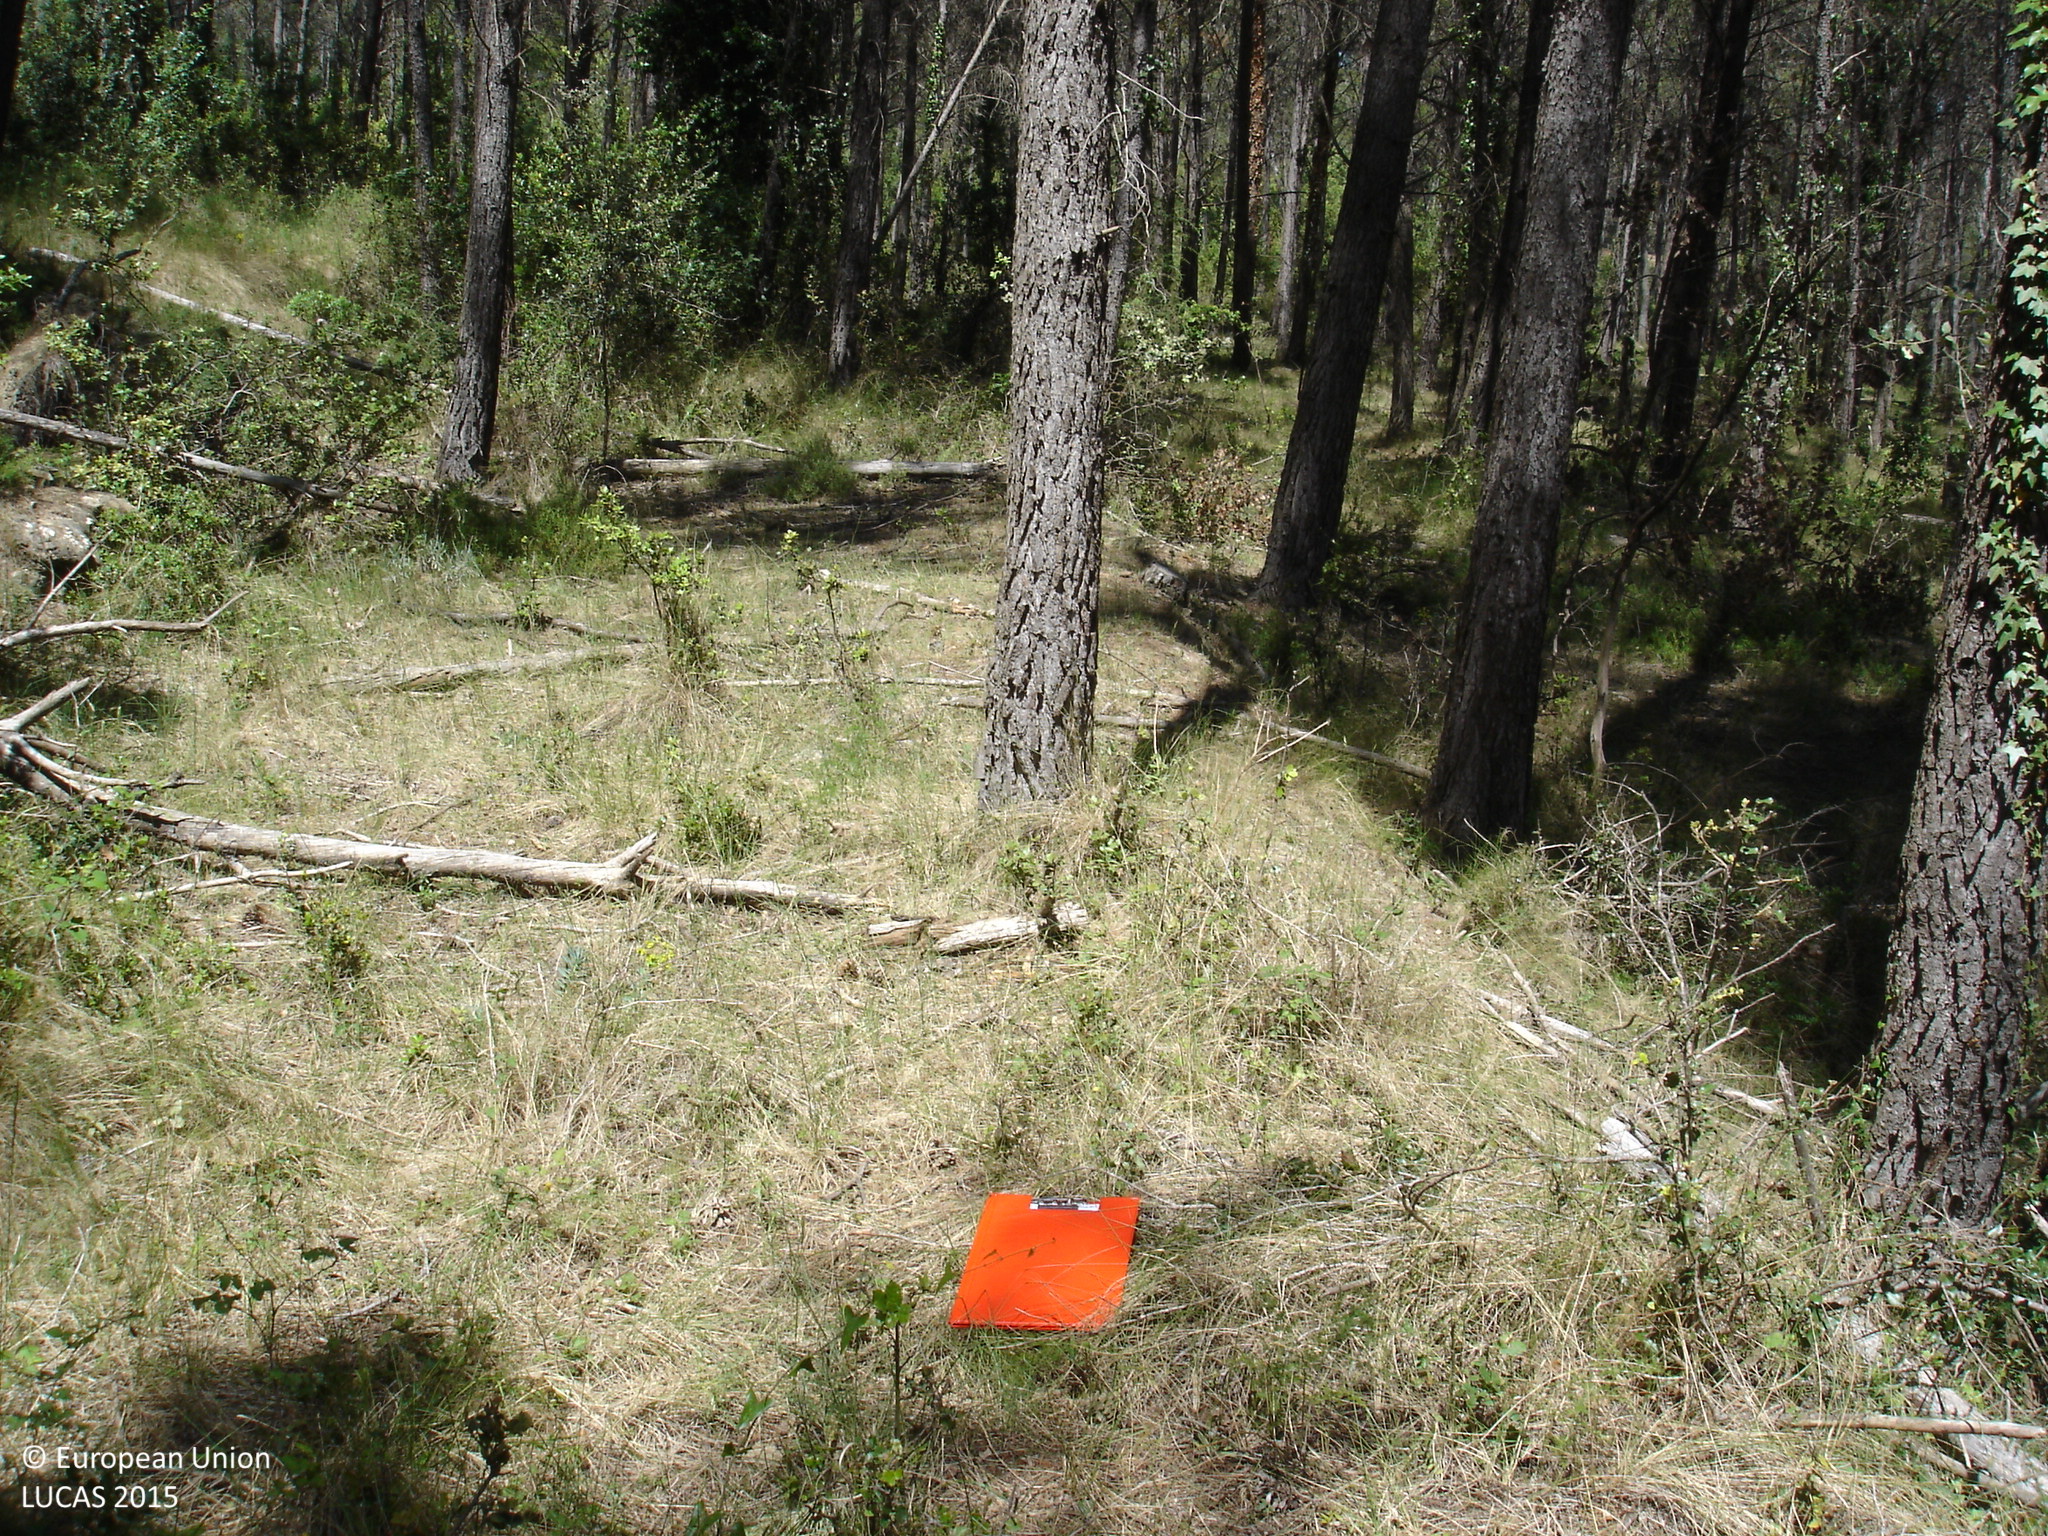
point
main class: Woodland
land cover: Pine dominated coniferous woodland
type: coniferous forest of the mediterranean region
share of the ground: > 75 %
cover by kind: coniferous forest trees 80 %, herbaceous plants 10 %, broadleaved forest trees 5 %, shrubs 5 %
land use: Forestry
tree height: > 5 m
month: May
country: ES
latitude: 42.0865
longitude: 3.0156
